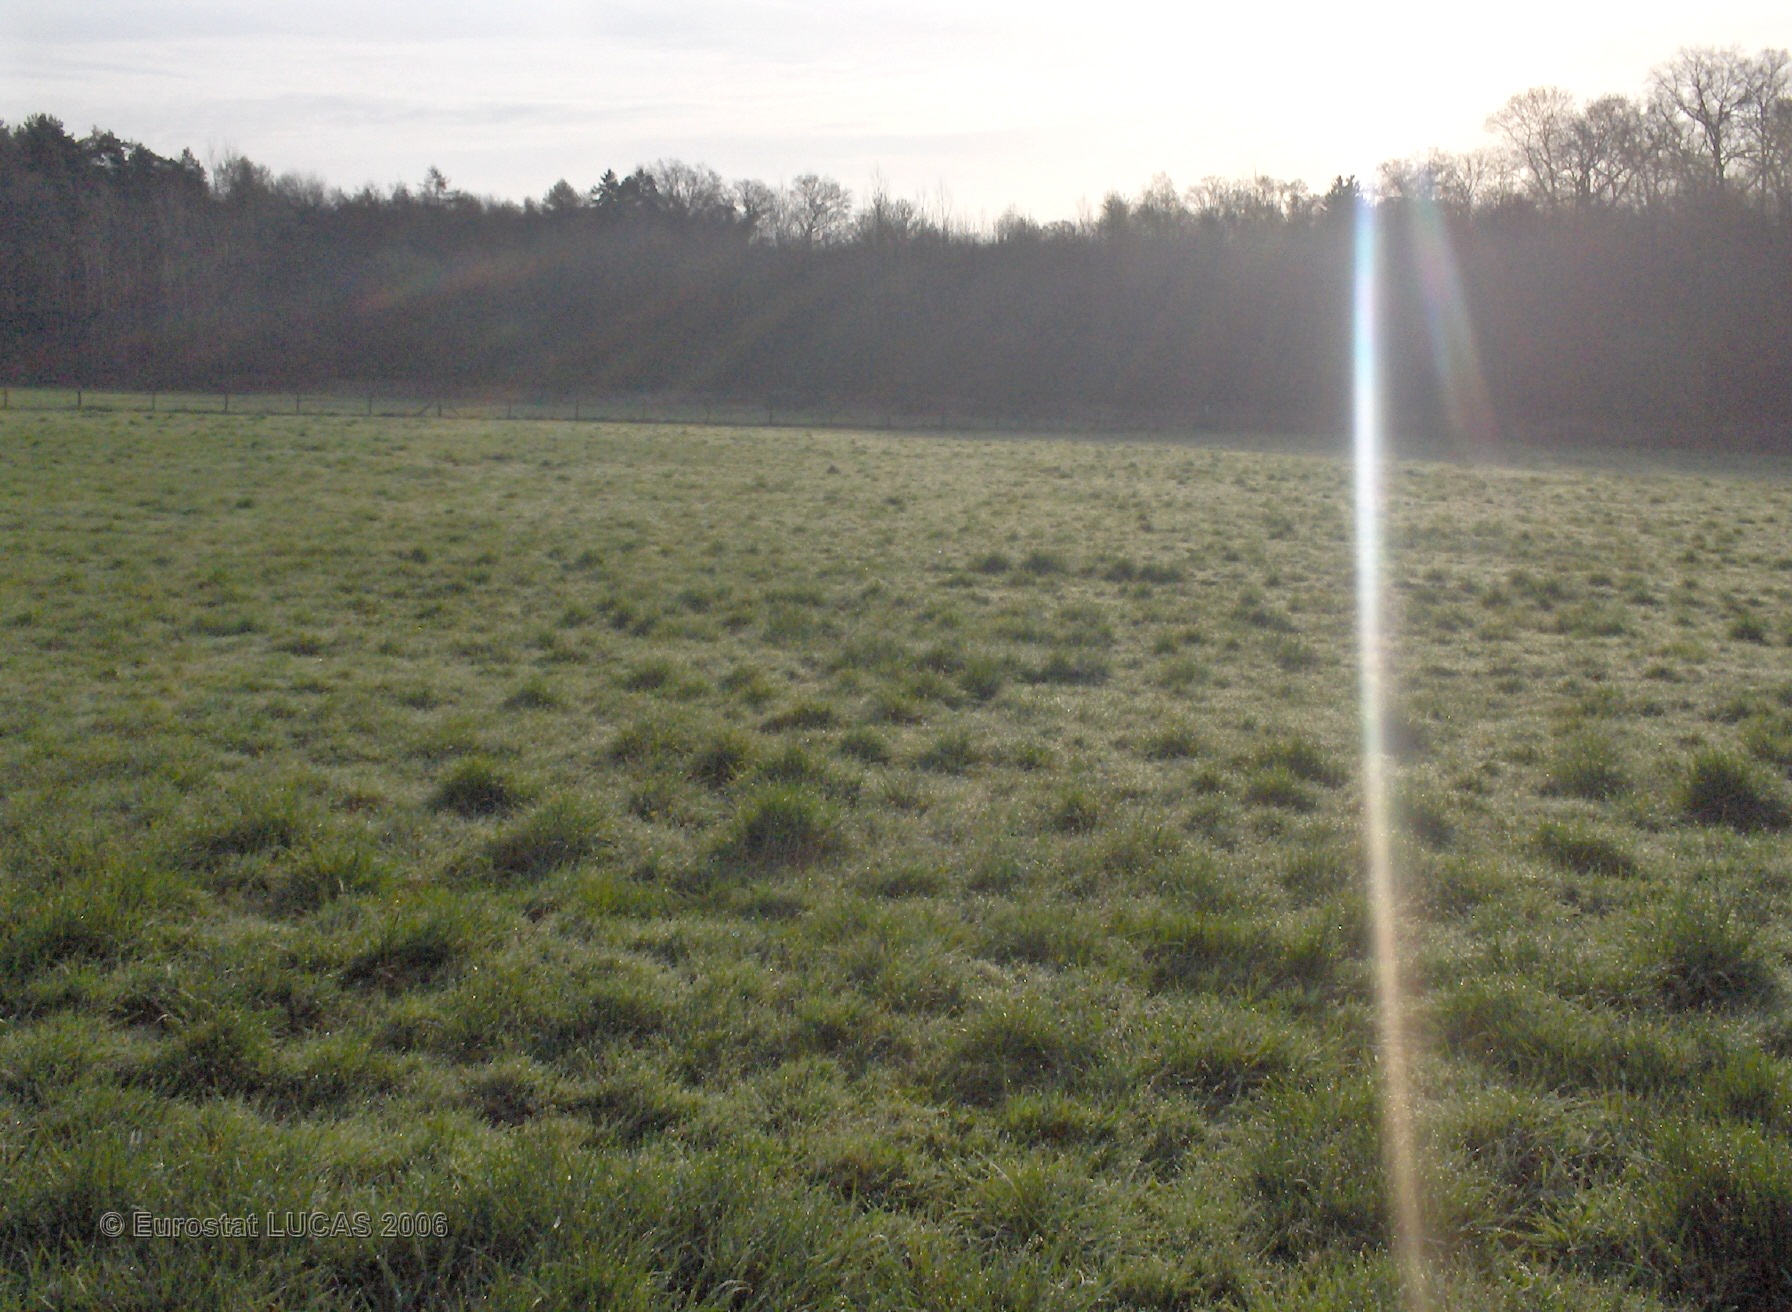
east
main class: Grassland
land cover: Grassland without tree/shrub cover
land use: Agriculture (excluding fallow land and kitchen gardens)
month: April
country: BE
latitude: 50.8582
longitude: 5.2100
